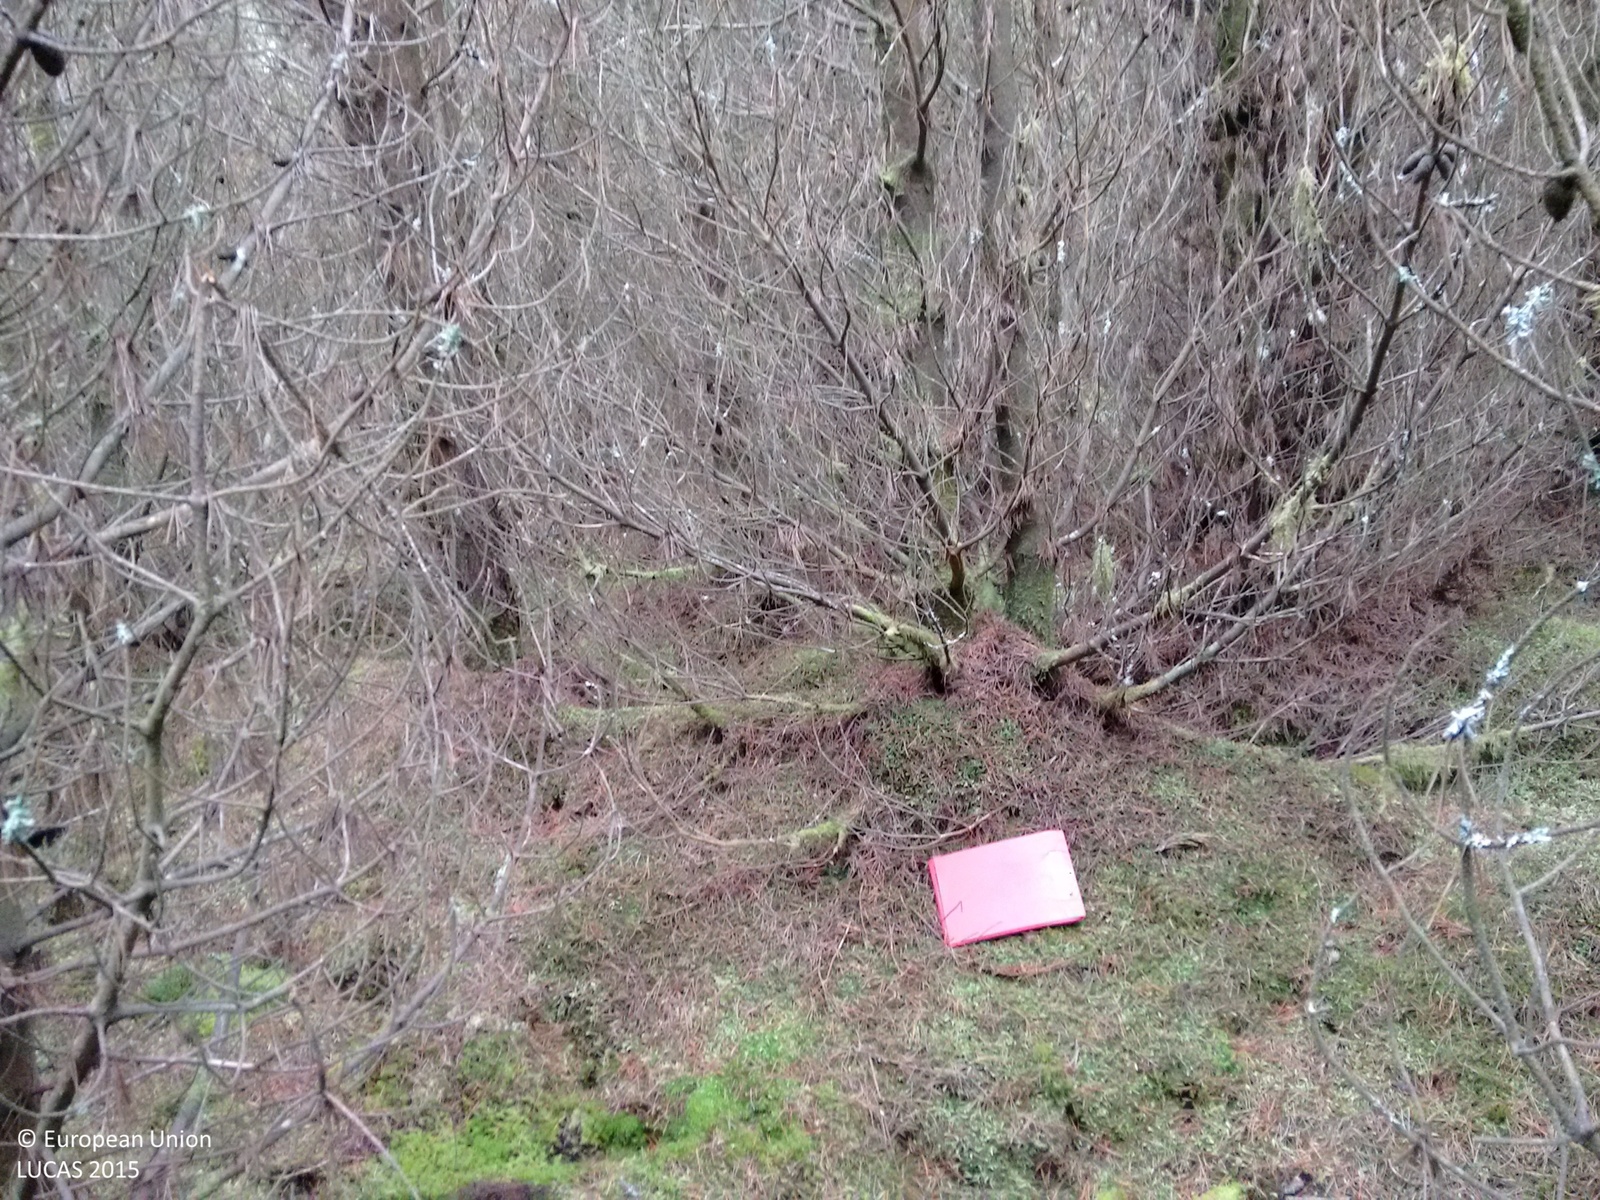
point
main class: Woodland
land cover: Pine dominated coniferous woodland
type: exotic forest
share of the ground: > 75 %
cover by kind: coniferous forest trees 100 %
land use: Forestry
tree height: > 5 m
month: August
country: GB
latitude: 58.6245
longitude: -3.1973
